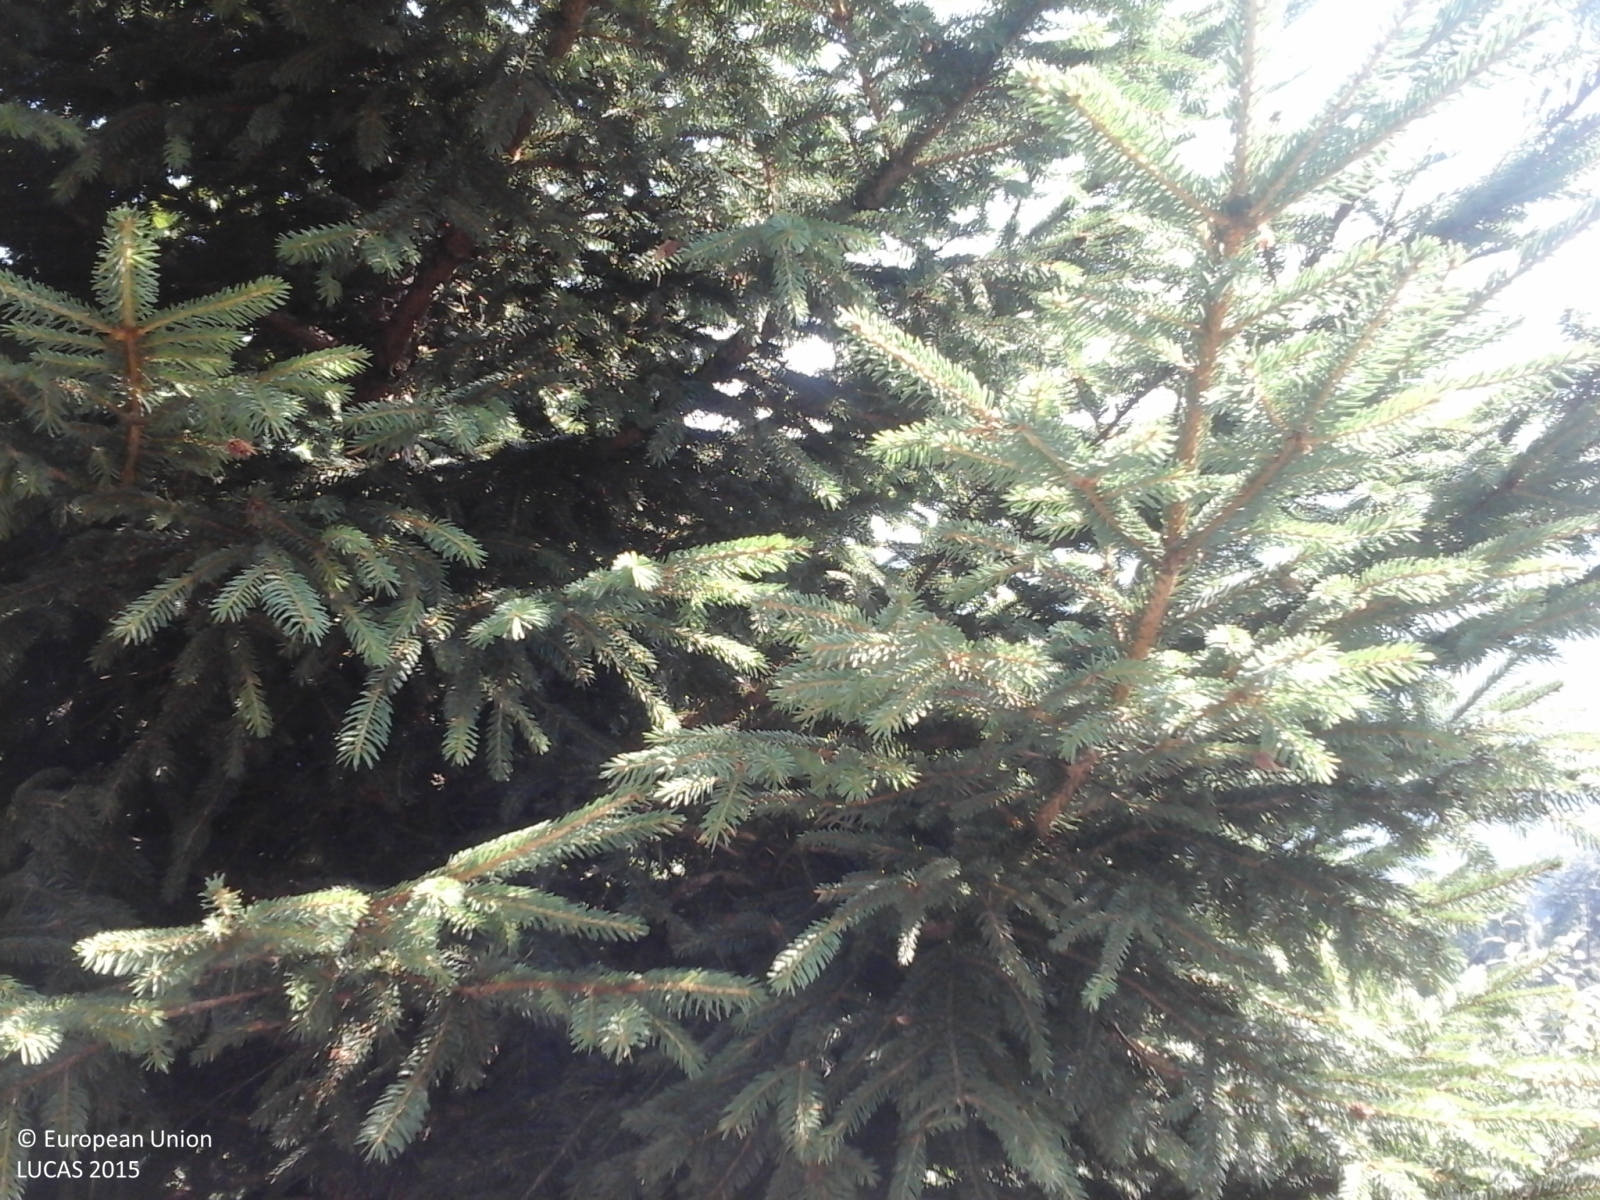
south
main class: Woodland
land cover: Broadleaved woodland
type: mesophytic deciduous forest
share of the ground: > 75 %
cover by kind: broadleaved forest trees 100 %
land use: Semi-natural and natural areas not in use
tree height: > 5 m
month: July
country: IT
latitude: 44.8723
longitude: 7.2076
